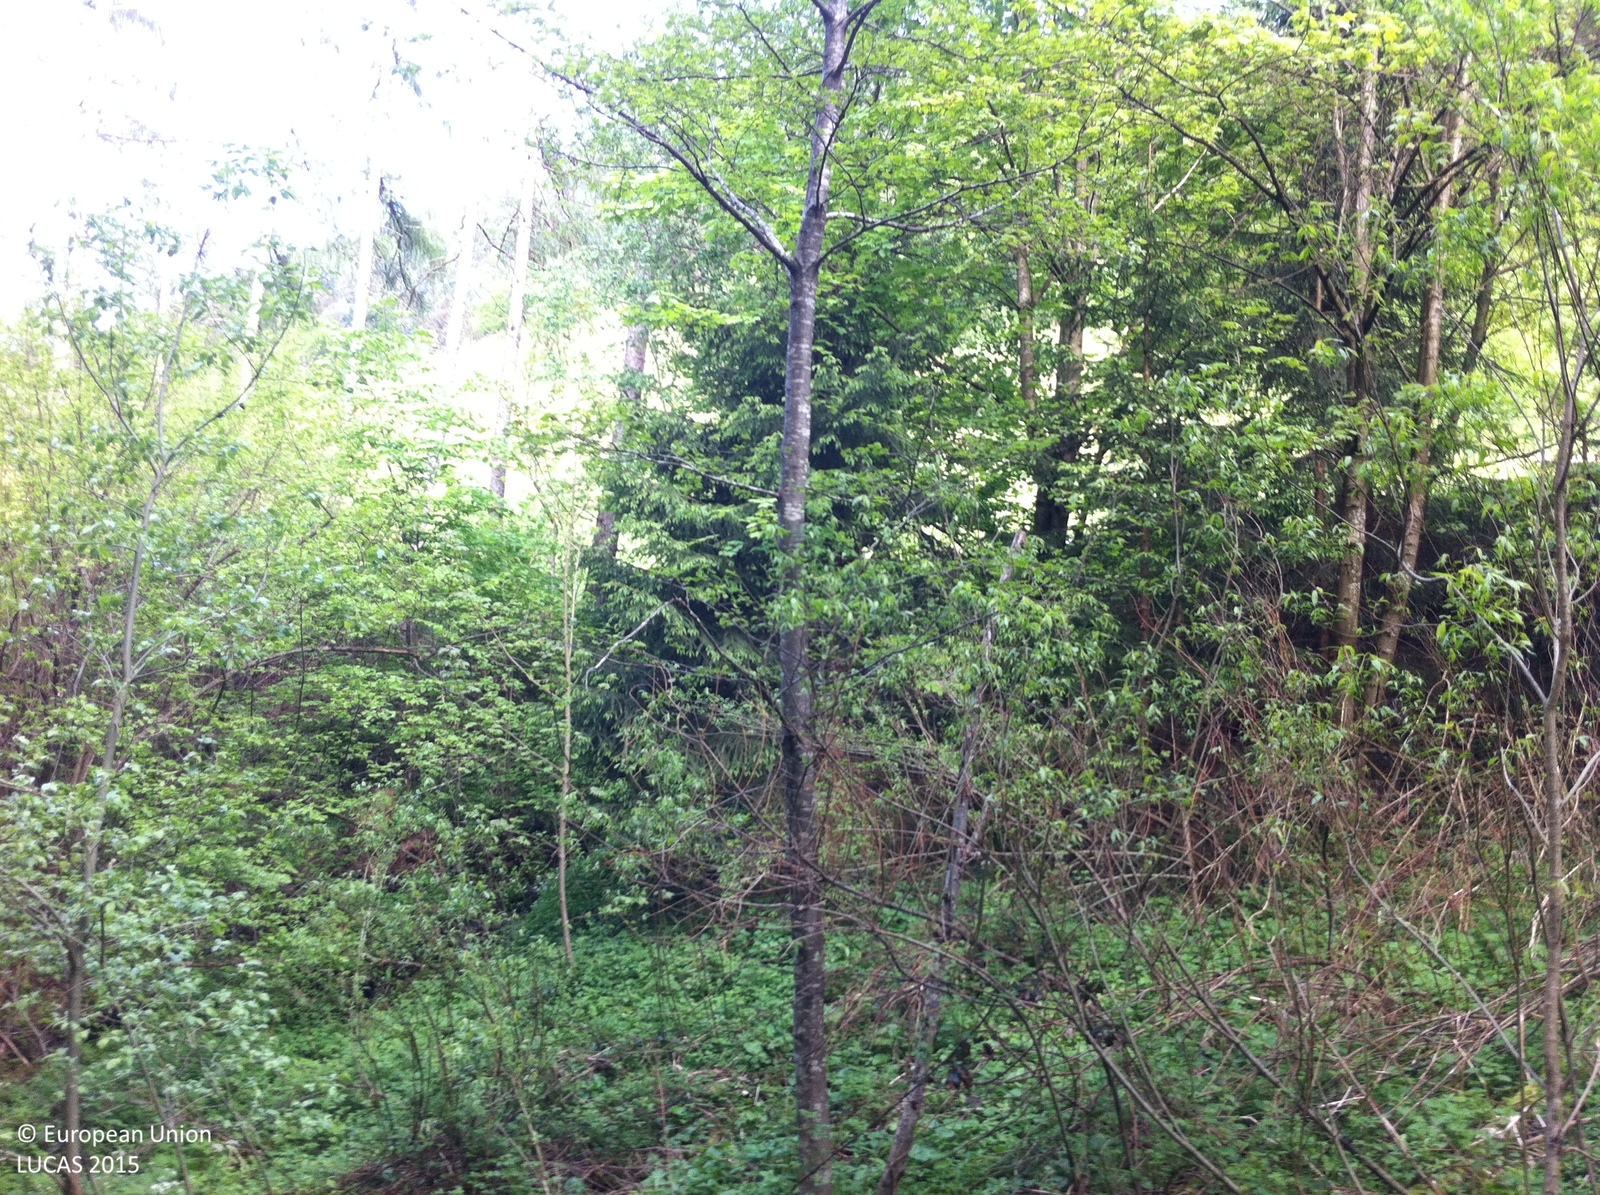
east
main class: Woodland
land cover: Broadleaved woodland
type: mesophytic deciduous forest
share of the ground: 50 - 75 %
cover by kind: broadleaved forest trees 70 %, shrubs 20 %, herbaceous plants 10 %
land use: Forestry
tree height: > 5 m
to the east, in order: Broadleaved woodland; Electric lines; Broadleaved woodland; Rivers and streams; Other mixed woodland; Grass margins; Paved roads, cycling and walking lanes; Grassland without tree/shrub cover; Fences; Broadleaved woodland; Grassland without tree/shrub cover; Fences; Tracks; Grassland without tree/shrub cover; Fences; Grass margins; Fences; Broadleaved woodland; Electric lines; Broadleaved woodland; Grassland without tree/shrub cover
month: May
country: AT
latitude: 47.3282
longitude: 11.7055
